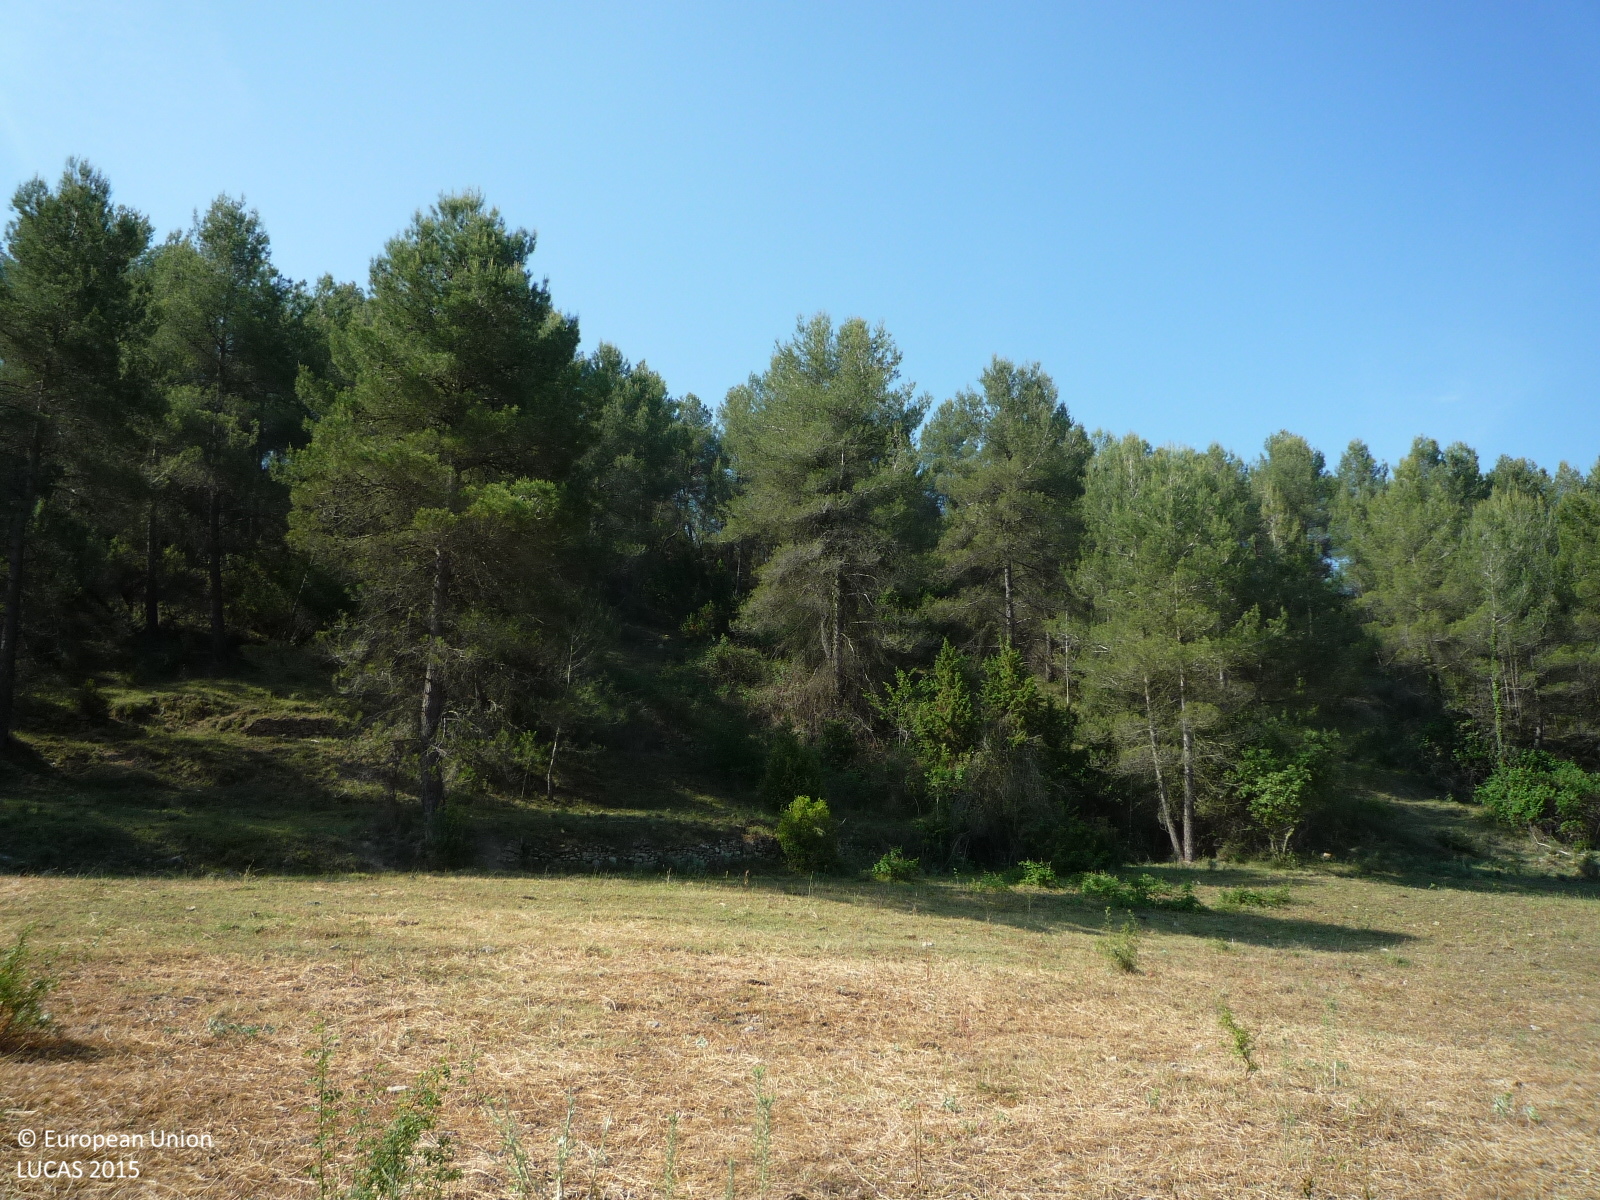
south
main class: Cropland
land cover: Temporary grasslands
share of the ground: > 75 %
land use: Agriculture (excluding fallow land and kitchen gardens)
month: June
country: ES
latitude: 41.6488
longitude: 1.7908
